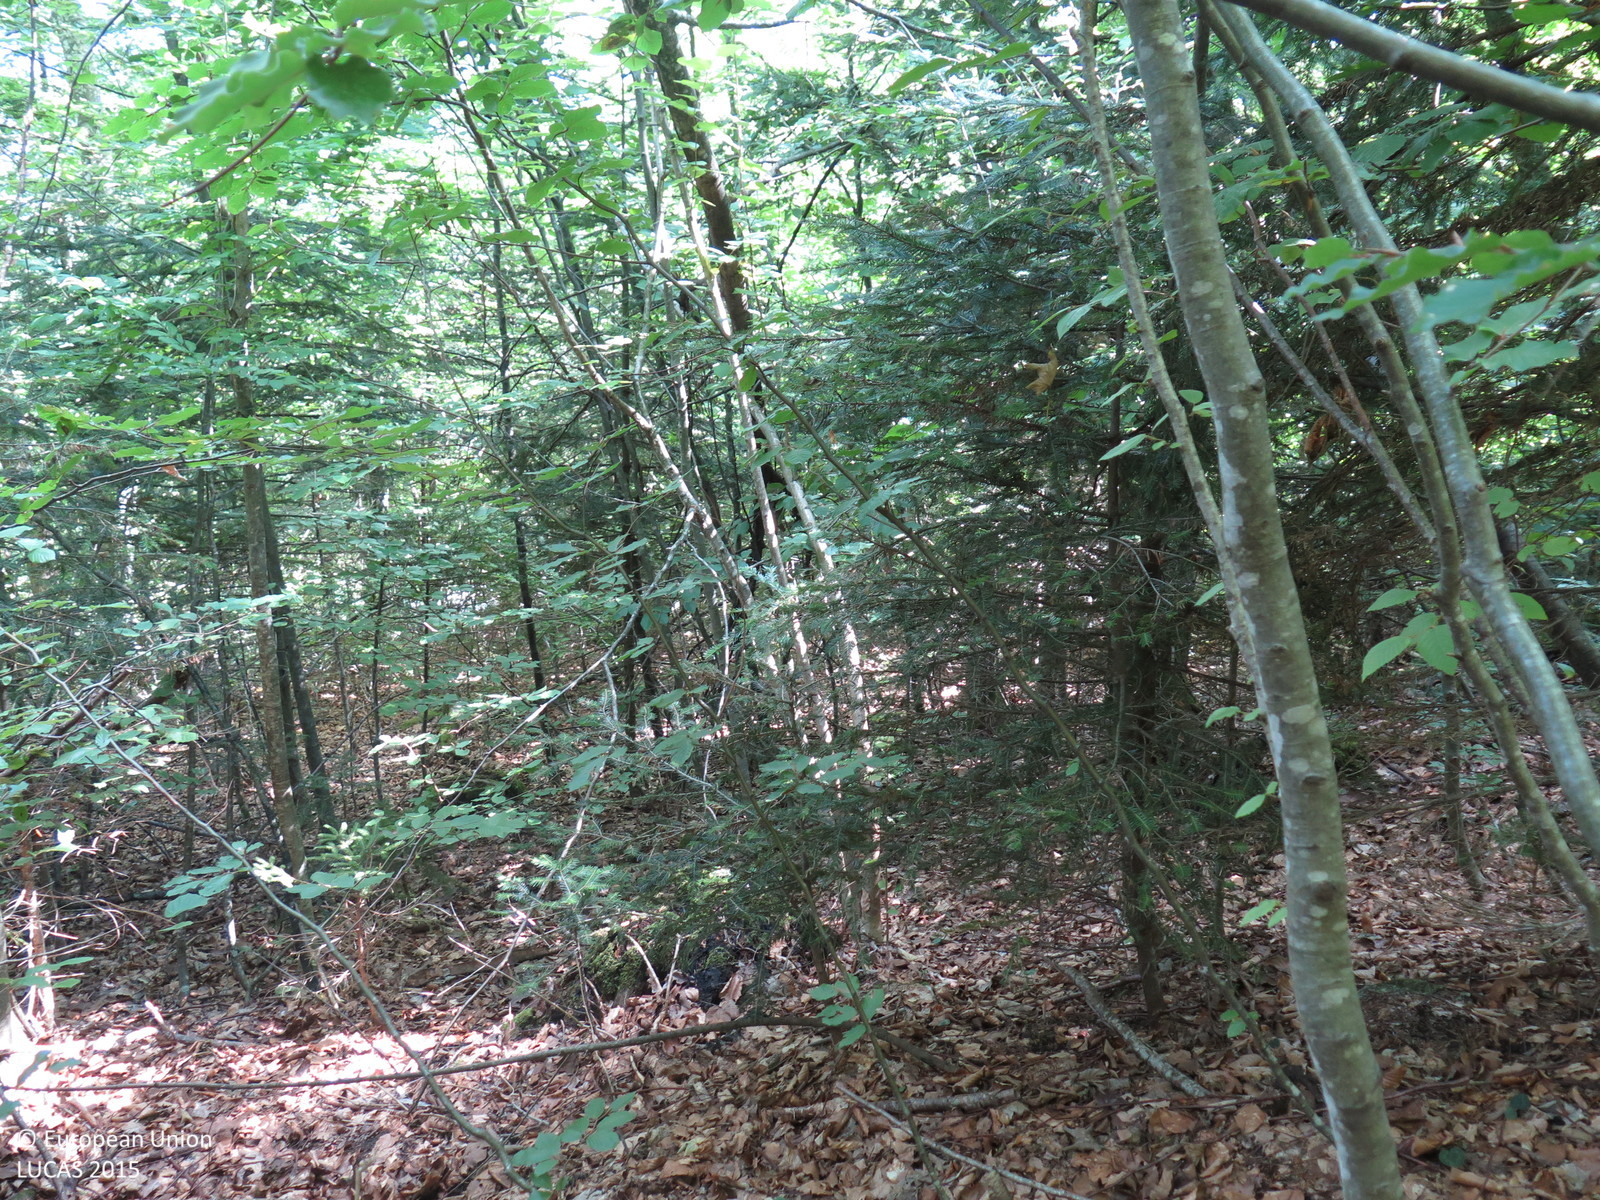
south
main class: Woodland
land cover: Broadleaved woodland
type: mountainous beech forest
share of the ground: > 75 %
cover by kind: broadleaved forest trees 90 %, herbaceous plants 5 %, unconsolidated bare surface 5 %
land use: Forestry
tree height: > 5 m
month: September
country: HR
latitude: 45.5252
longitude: 14.7200
